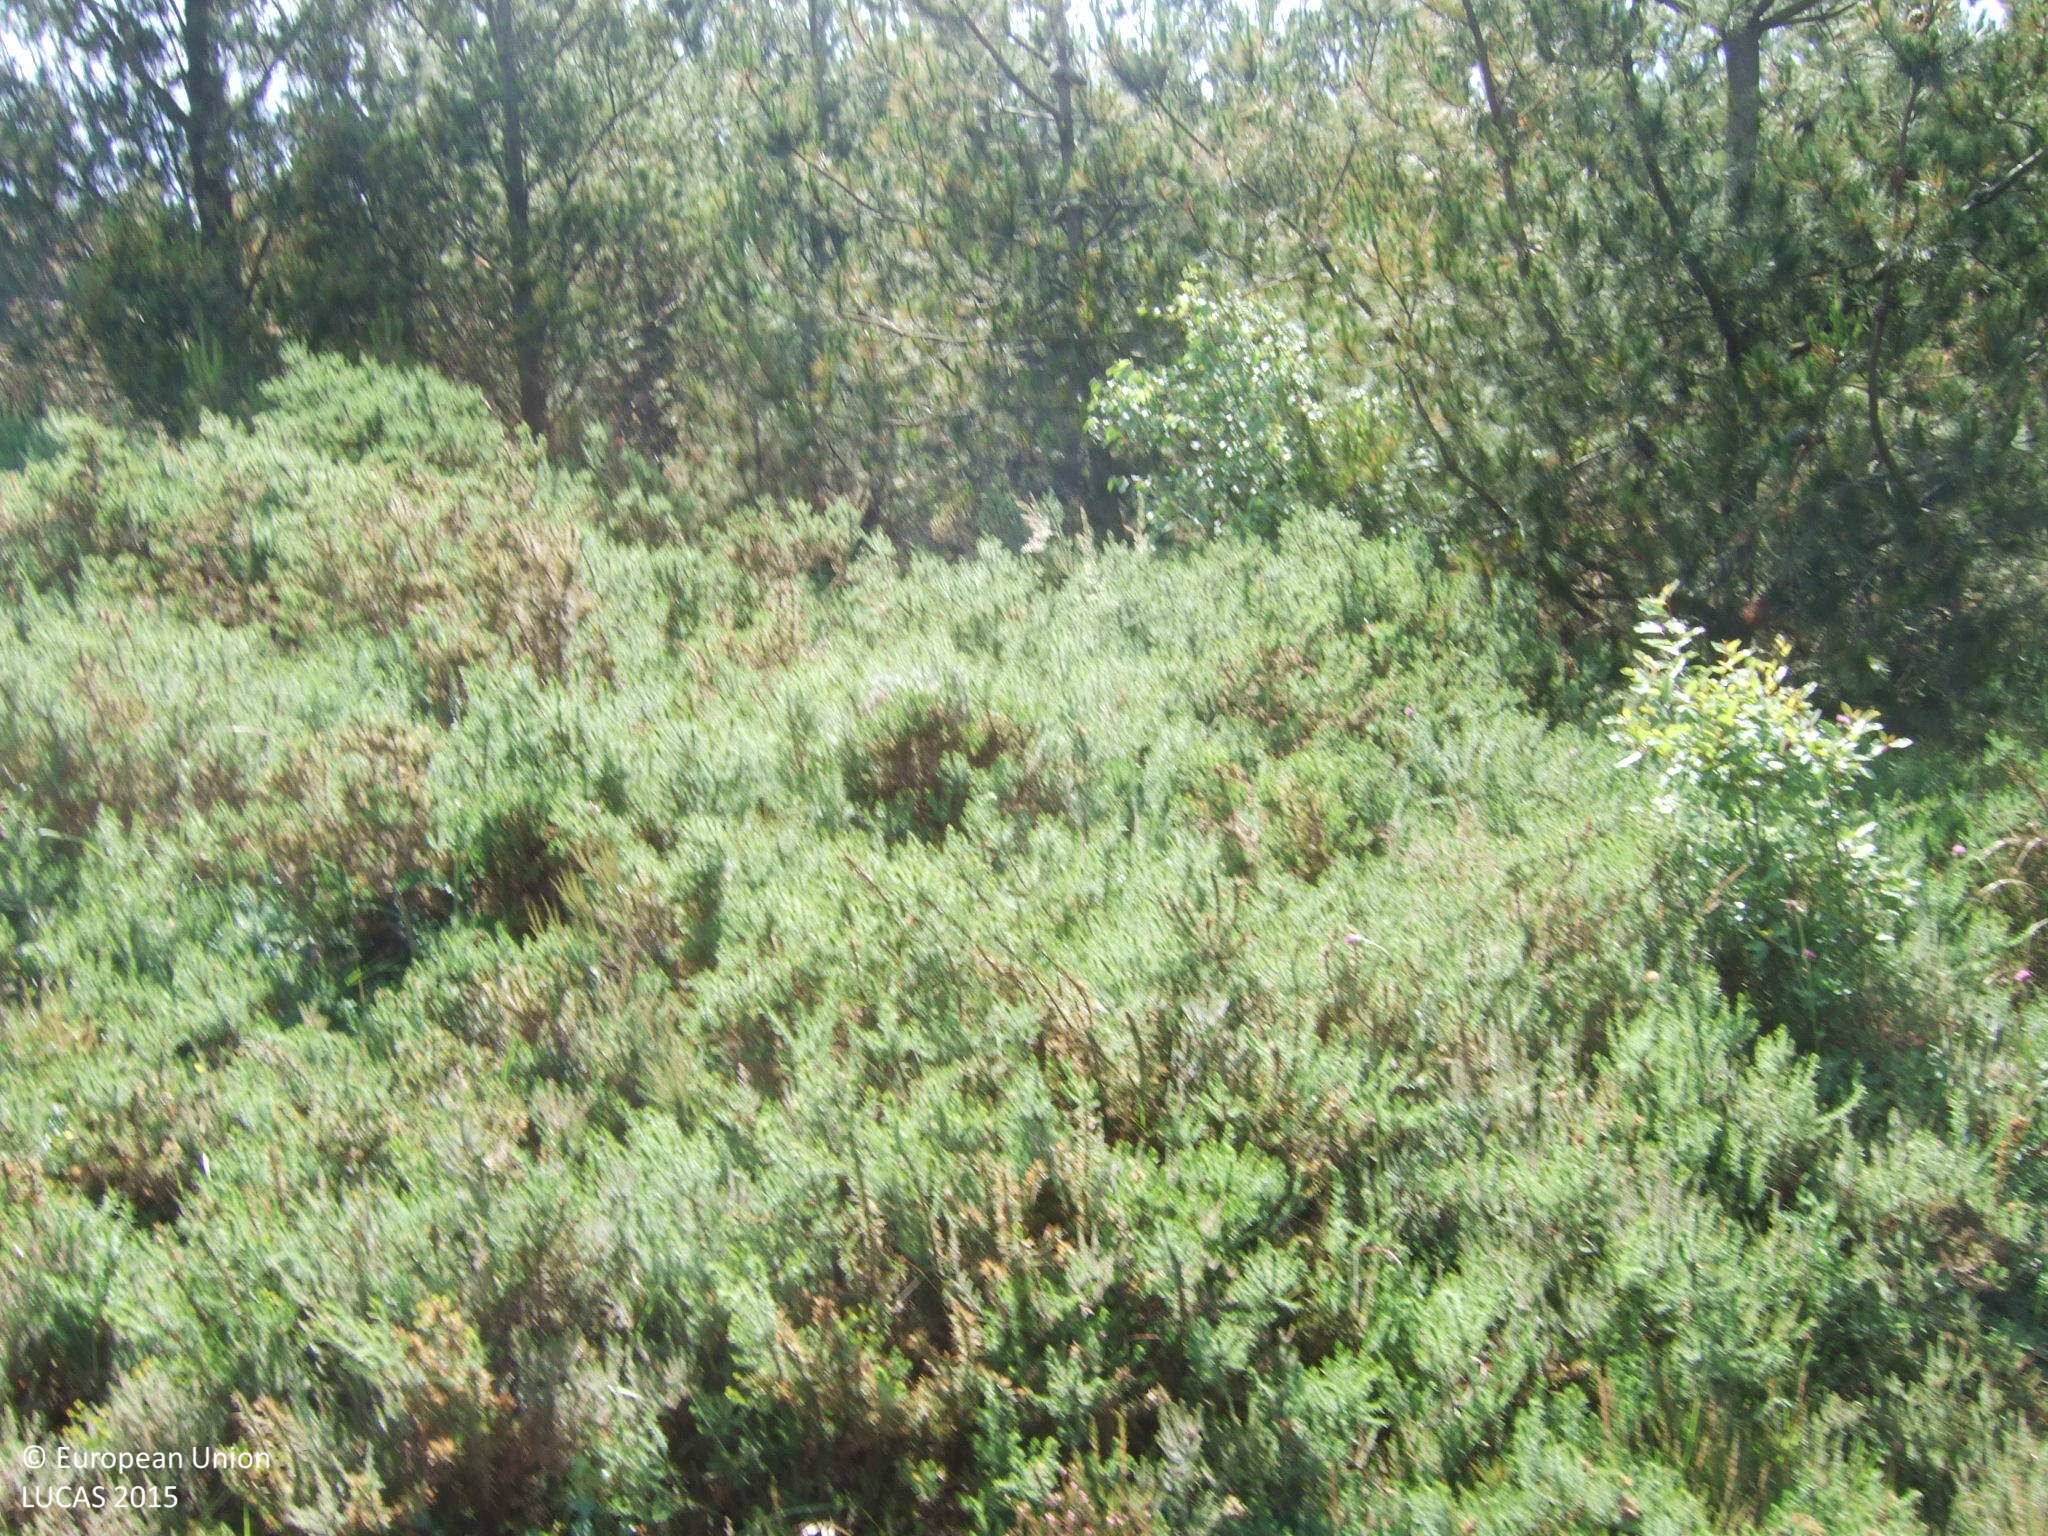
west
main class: Woodland
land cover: Pine dominated coniferous woodland
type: exotic forest
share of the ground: 50 - 75 %
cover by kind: coniferous forest trees 70 %, shrubs 30 %
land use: Forestry
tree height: < 5 m
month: June
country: ES
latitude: 43.4425
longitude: -7.7951
